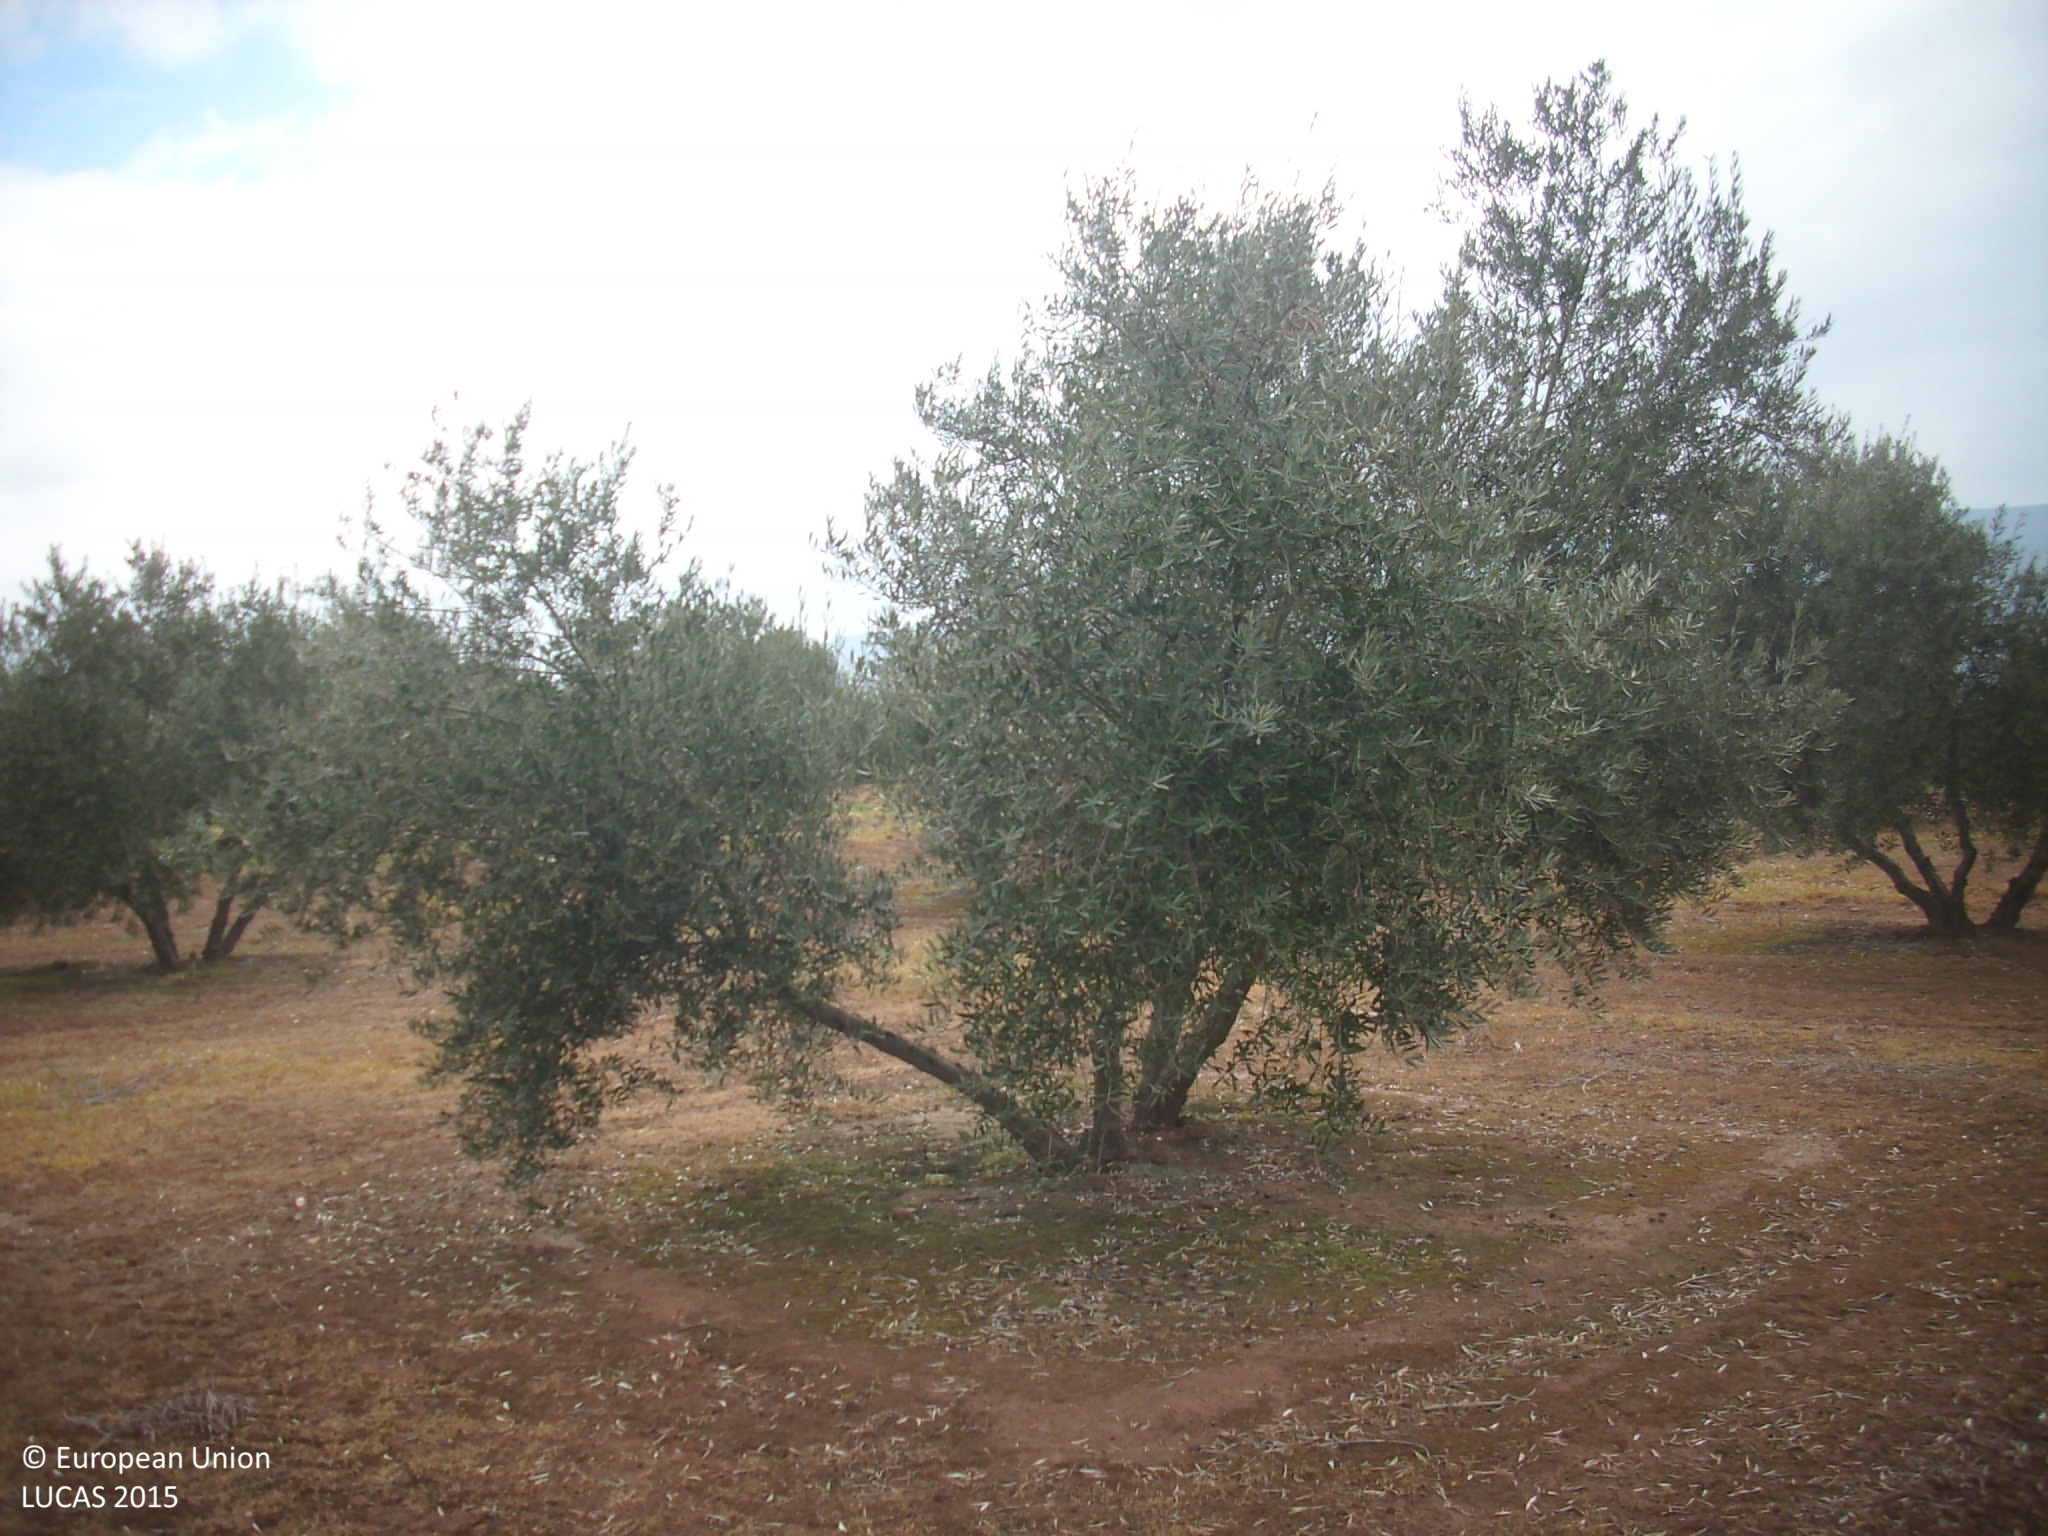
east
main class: Cropland
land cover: Olive groves
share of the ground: 25 - 50 %
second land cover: Spontaneously vegetated surfaces
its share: 50 - 75 %
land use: Agriculture (excluding fallow land and kitchen gardens)
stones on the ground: < 10 %
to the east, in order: Olive groves; Spontaneously vegetated surfaces; Other bare soil; Grass margins; Olive groves; Grass margins; Ditches and canals; Grass margins; Tracks; Olive groves
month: March
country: ES
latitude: 38.3195
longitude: -3.1213
